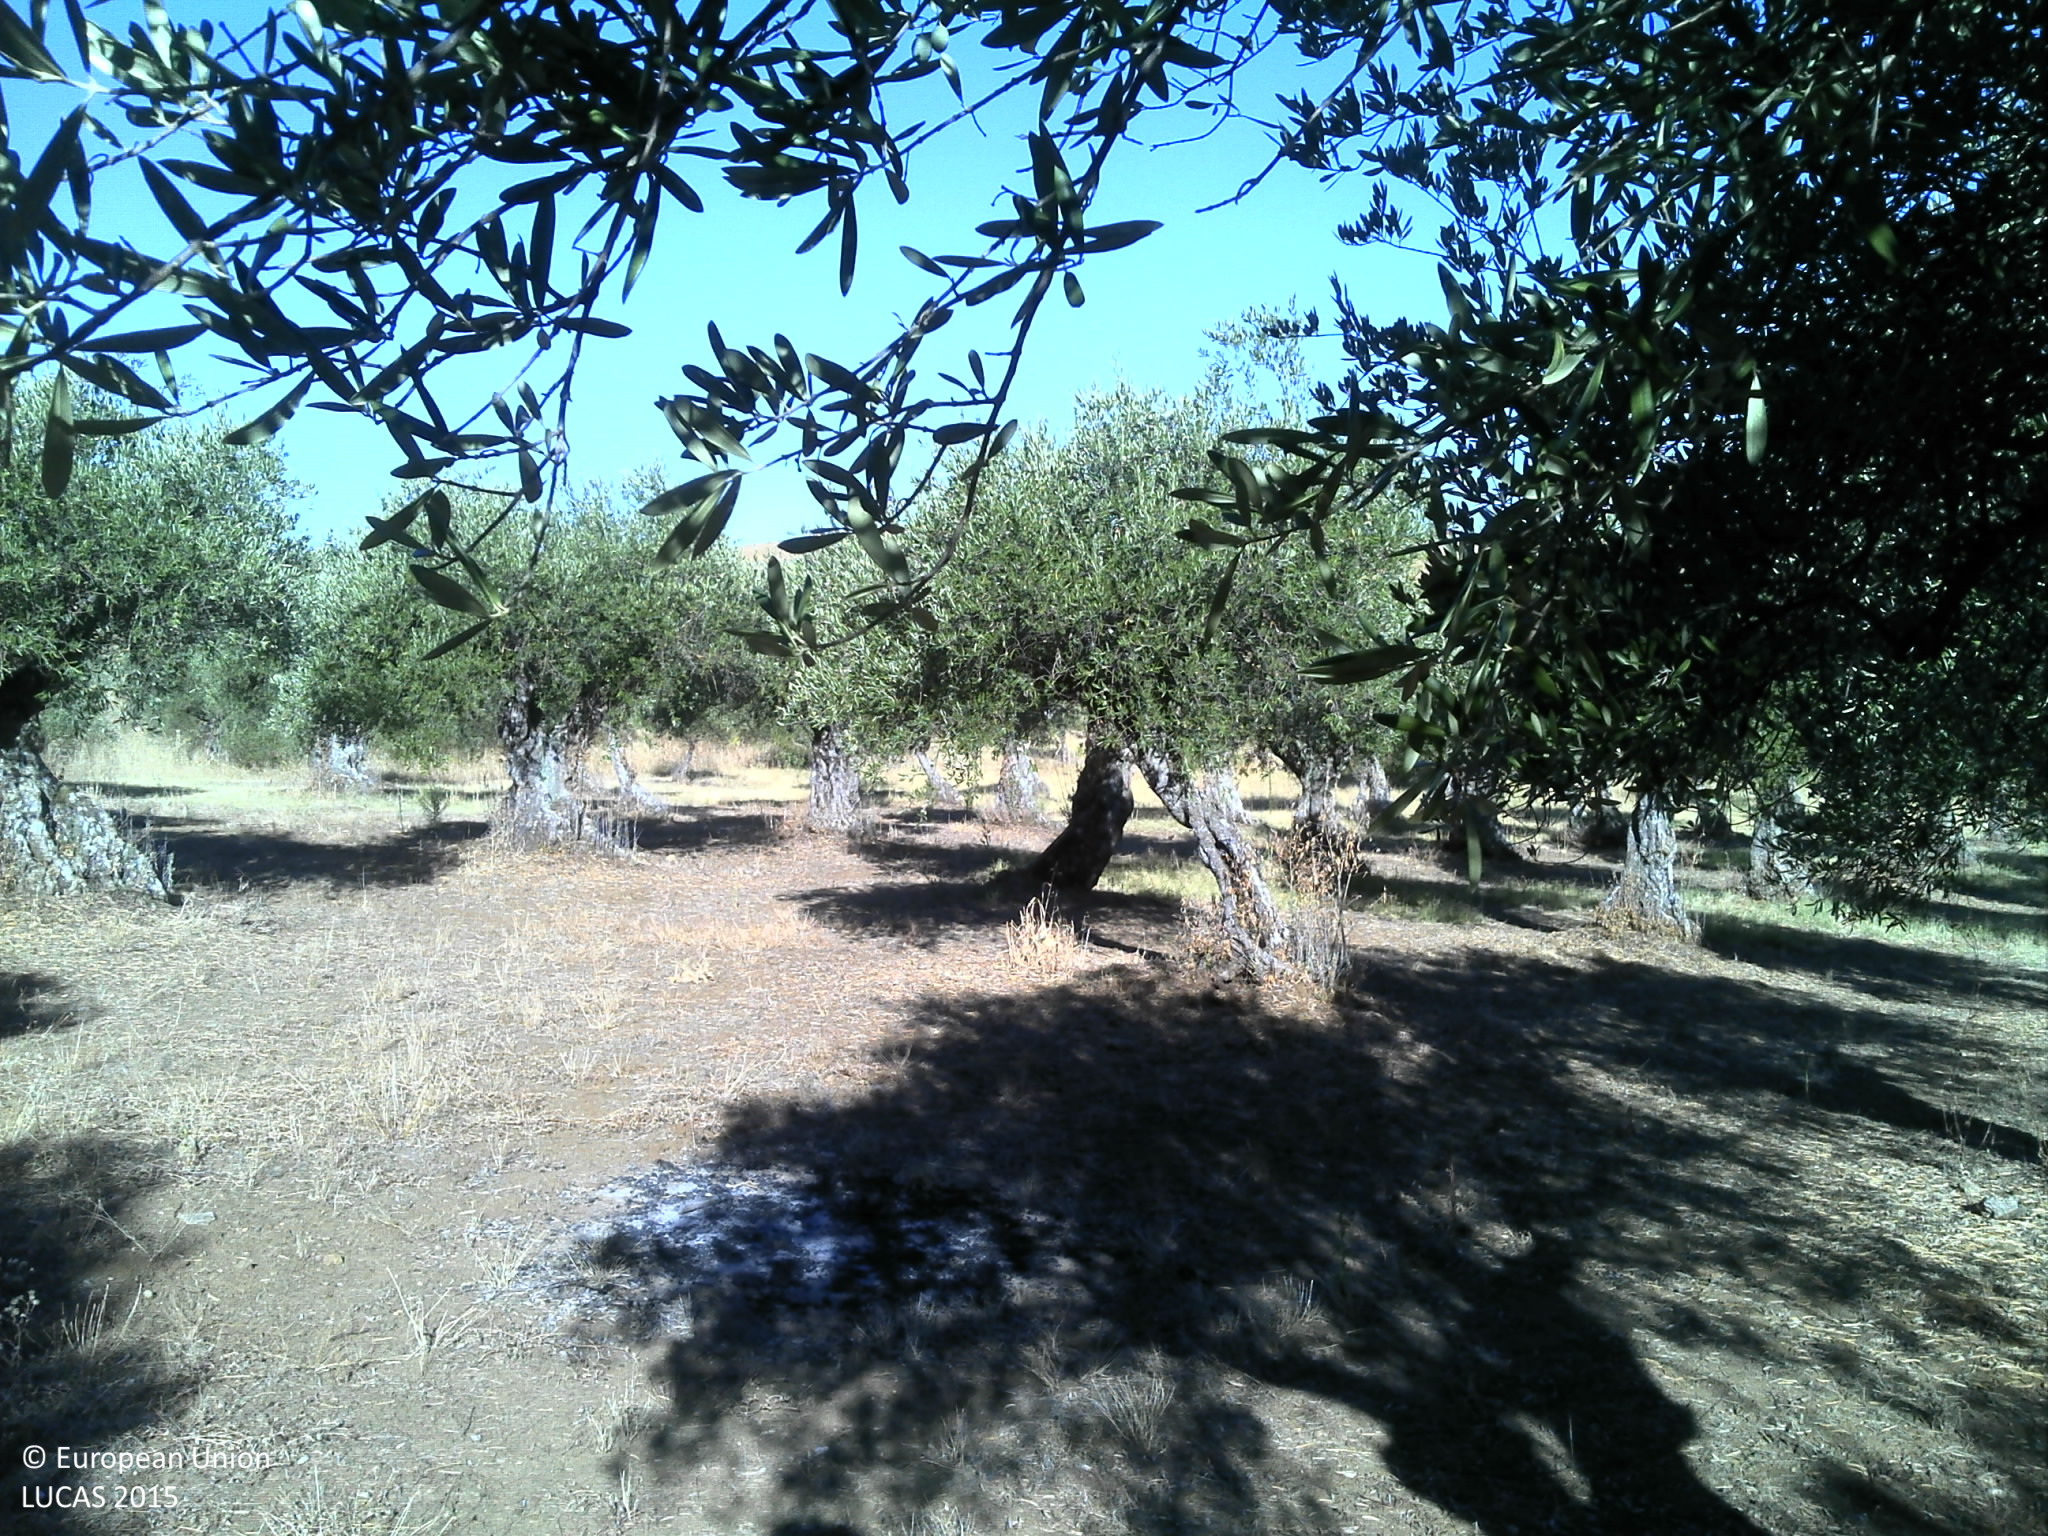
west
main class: Cropland
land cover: Olive groves
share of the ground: 25 - 50 %
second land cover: Grassland without tree/shrub cover
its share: < 10 %
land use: Agriculture (excluding fallow land and kitchen gardens)
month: July
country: PT
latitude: 39.0262
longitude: -7.0188
